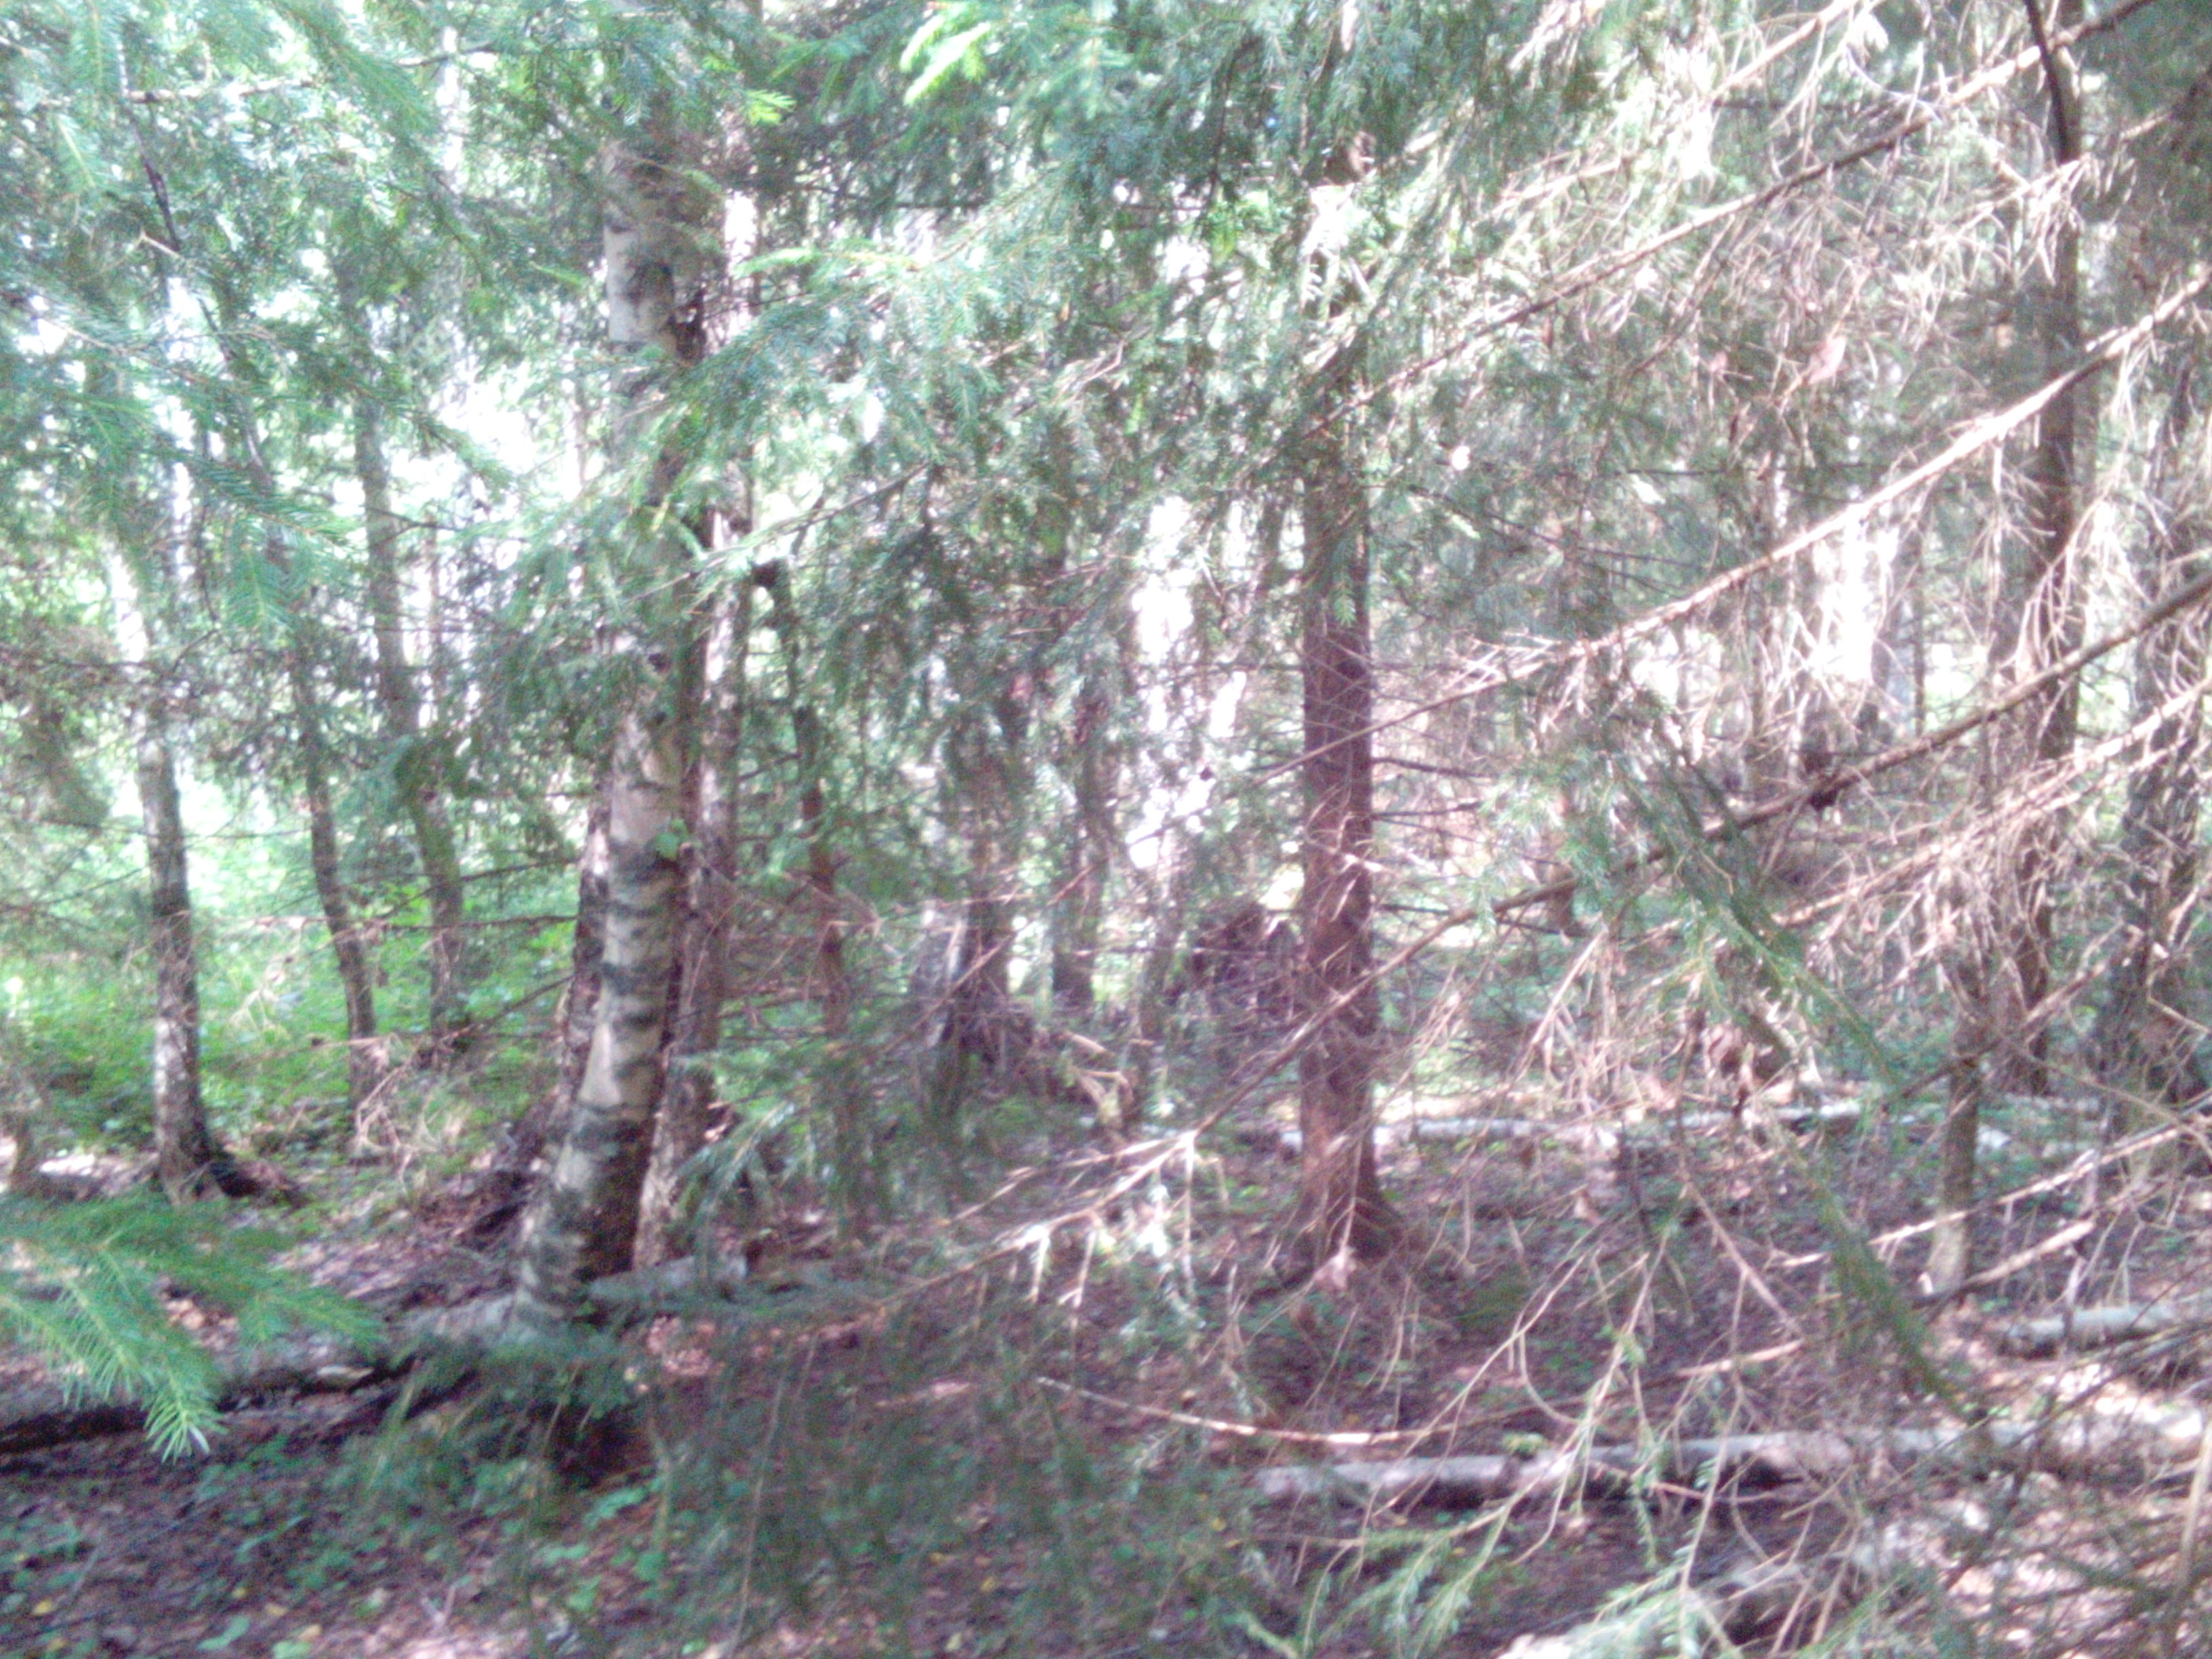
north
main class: Woodland
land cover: Spruce dominated mixed woodland
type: hemiboreal forest and nemoral coniferous forest and mixed broadleaved-coniferous forest
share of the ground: > 75 %
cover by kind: coniferous forest trees 40 %, broadleaved forest trees 40 %, herbaceous plants 10 %, unconsolidated bare surface 10 %
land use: Forestry
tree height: > 5 m
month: July
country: LV
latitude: 56.7734
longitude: 21.3462
